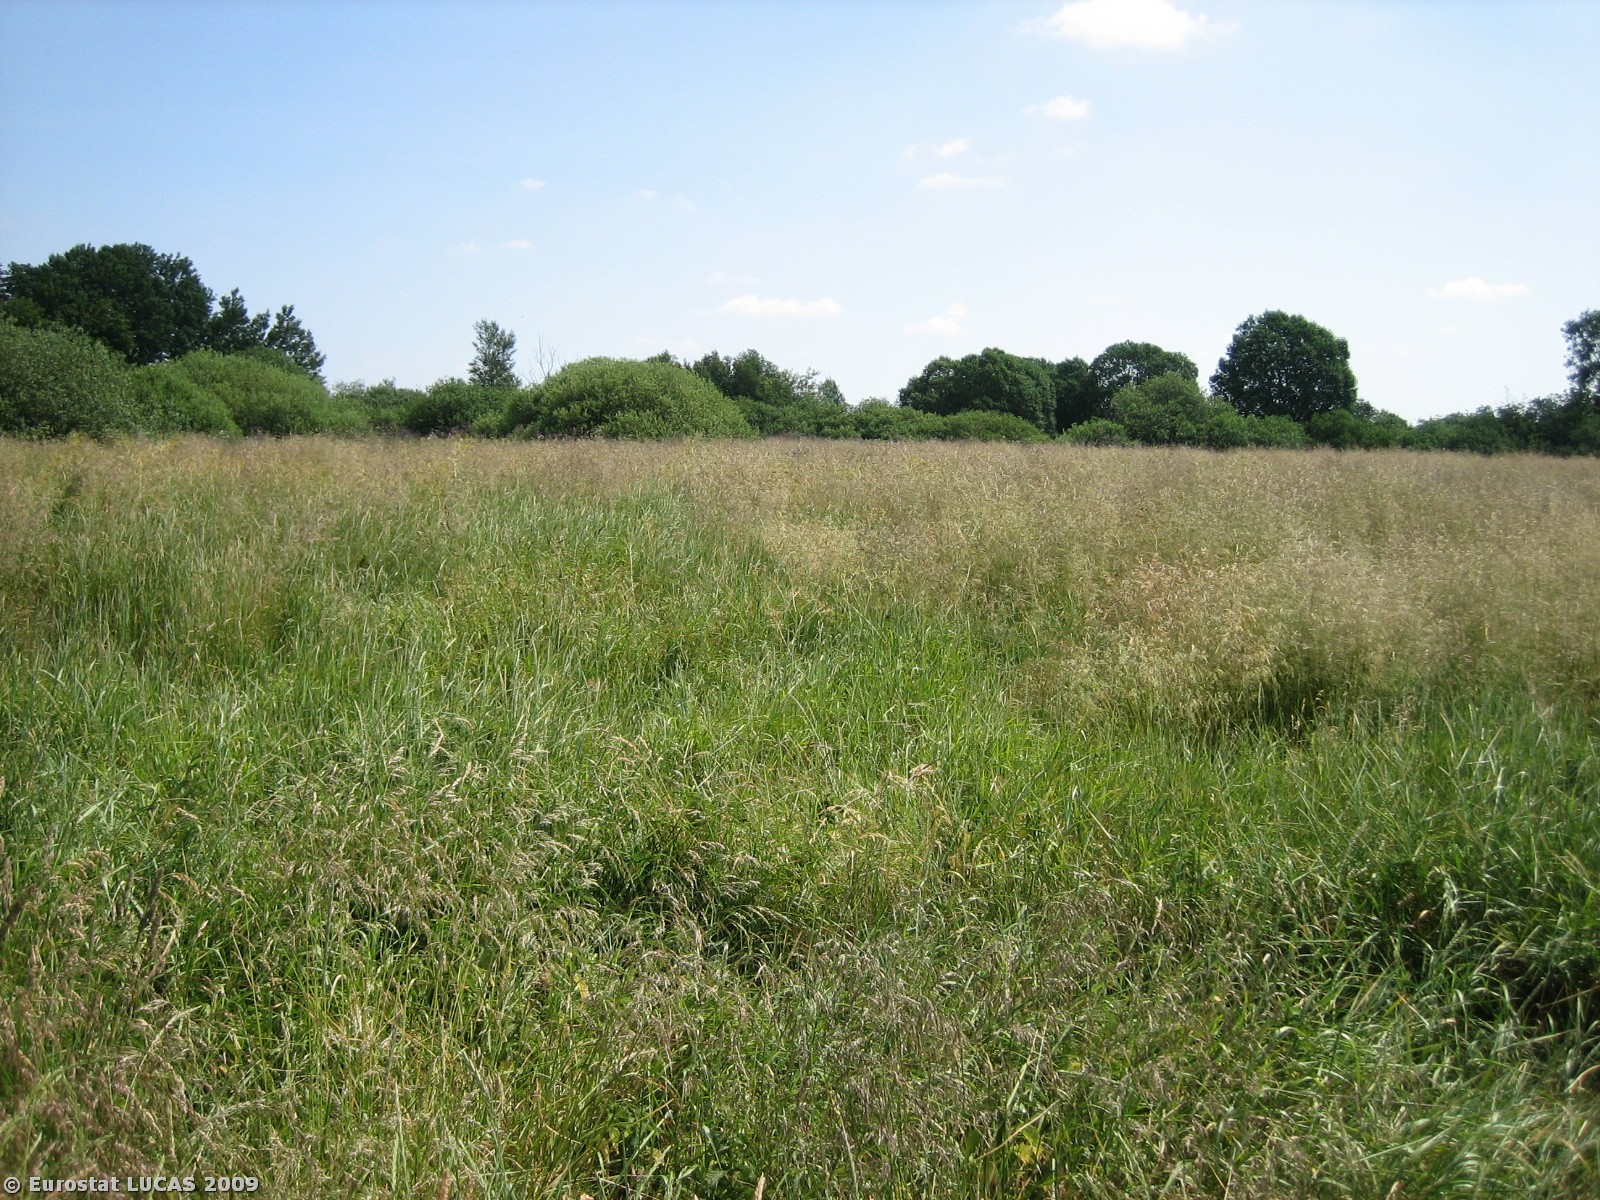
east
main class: Grassland
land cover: Grassland without tree/shrub cover
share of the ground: > 75 %
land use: Unused
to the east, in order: Grassland without tree/shrub cover; Shrubland with sparse tree cover; Grassland without tree/shrub cover; Grass margins; Grassland without tree/shrub cover; Fences; Broadleaved woodland; Inland water bodies; Broadleaved woodland; Fences; Grassland without tree/shrub cover; Fences; Broadleaved woodland; Grassland without tree/shrub cover; Single bushes/trees; Grassland without tree/shrub cover
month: July
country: DK
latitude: 55.4458
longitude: 8.8786
